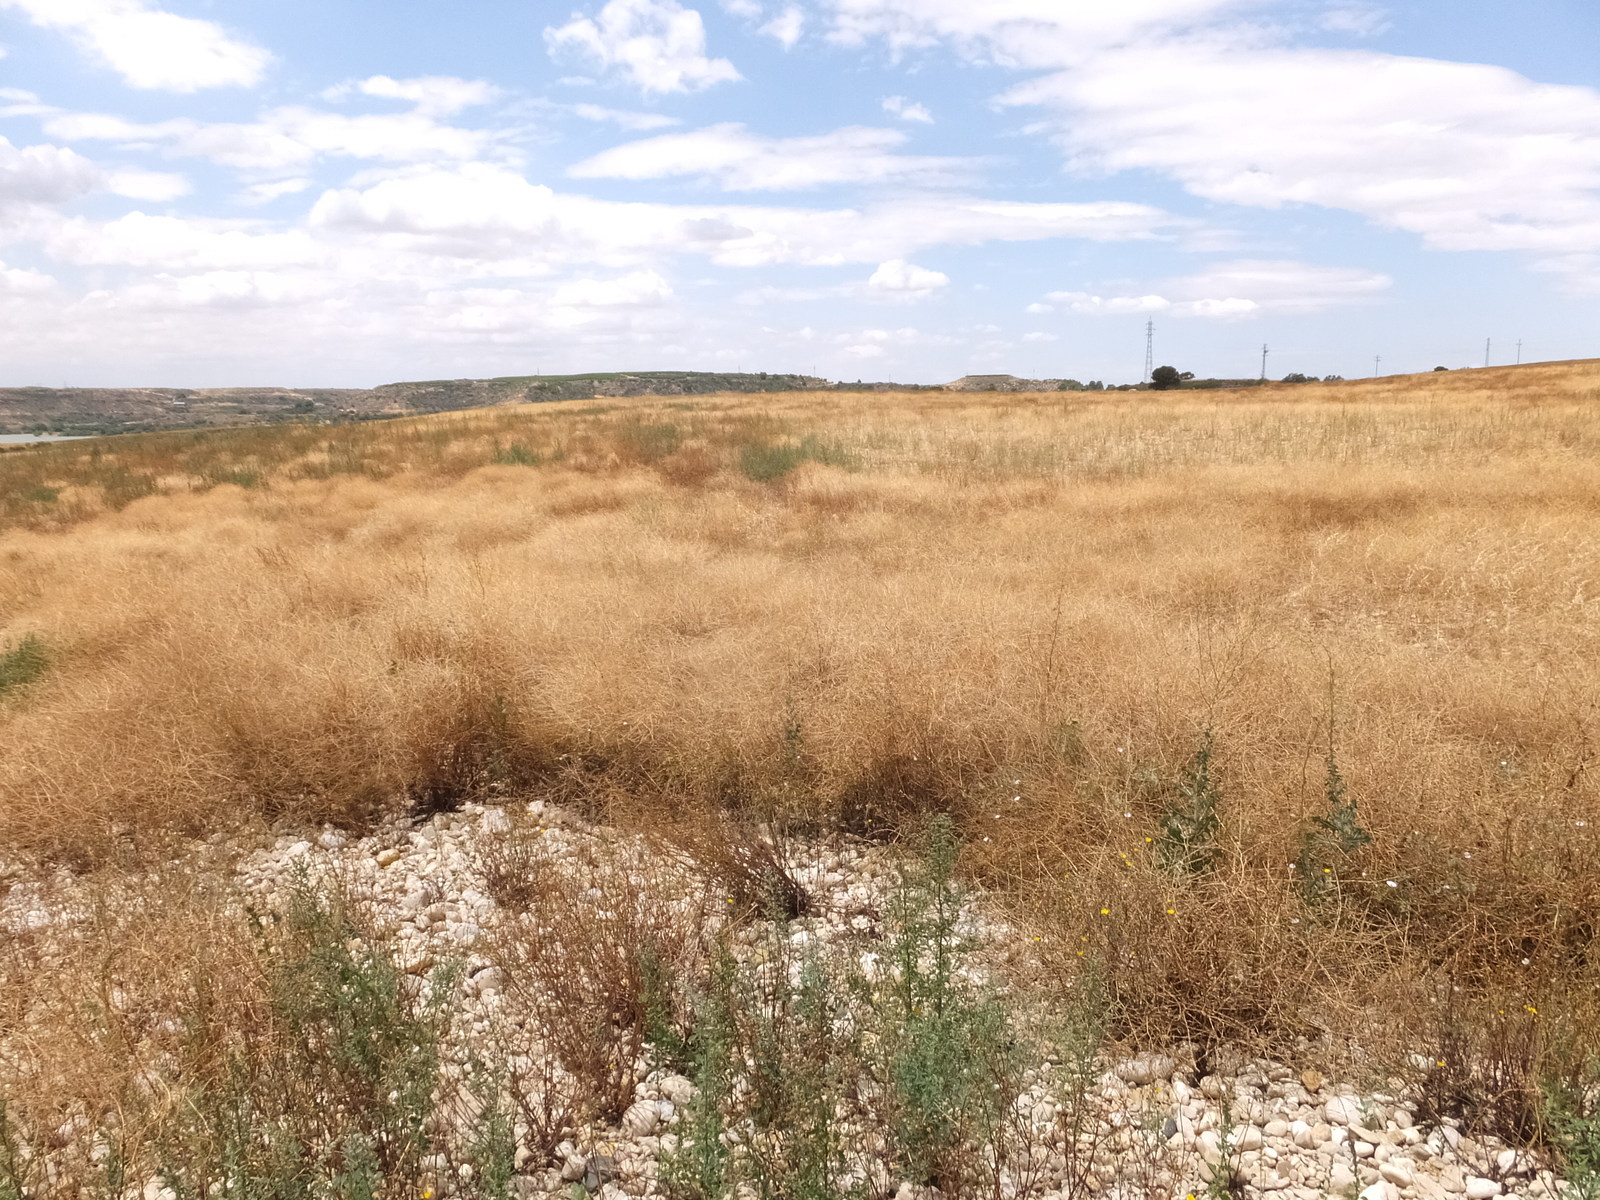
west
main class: Grassland
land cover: Spontaneously vegetated surfaces
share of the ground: 25 - 50 %
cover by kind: consolidated bare surface 80 %, herbaceous plants 20 %
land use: Fallow land
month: June
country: ES
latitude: 41.2614
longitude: -0.0508
